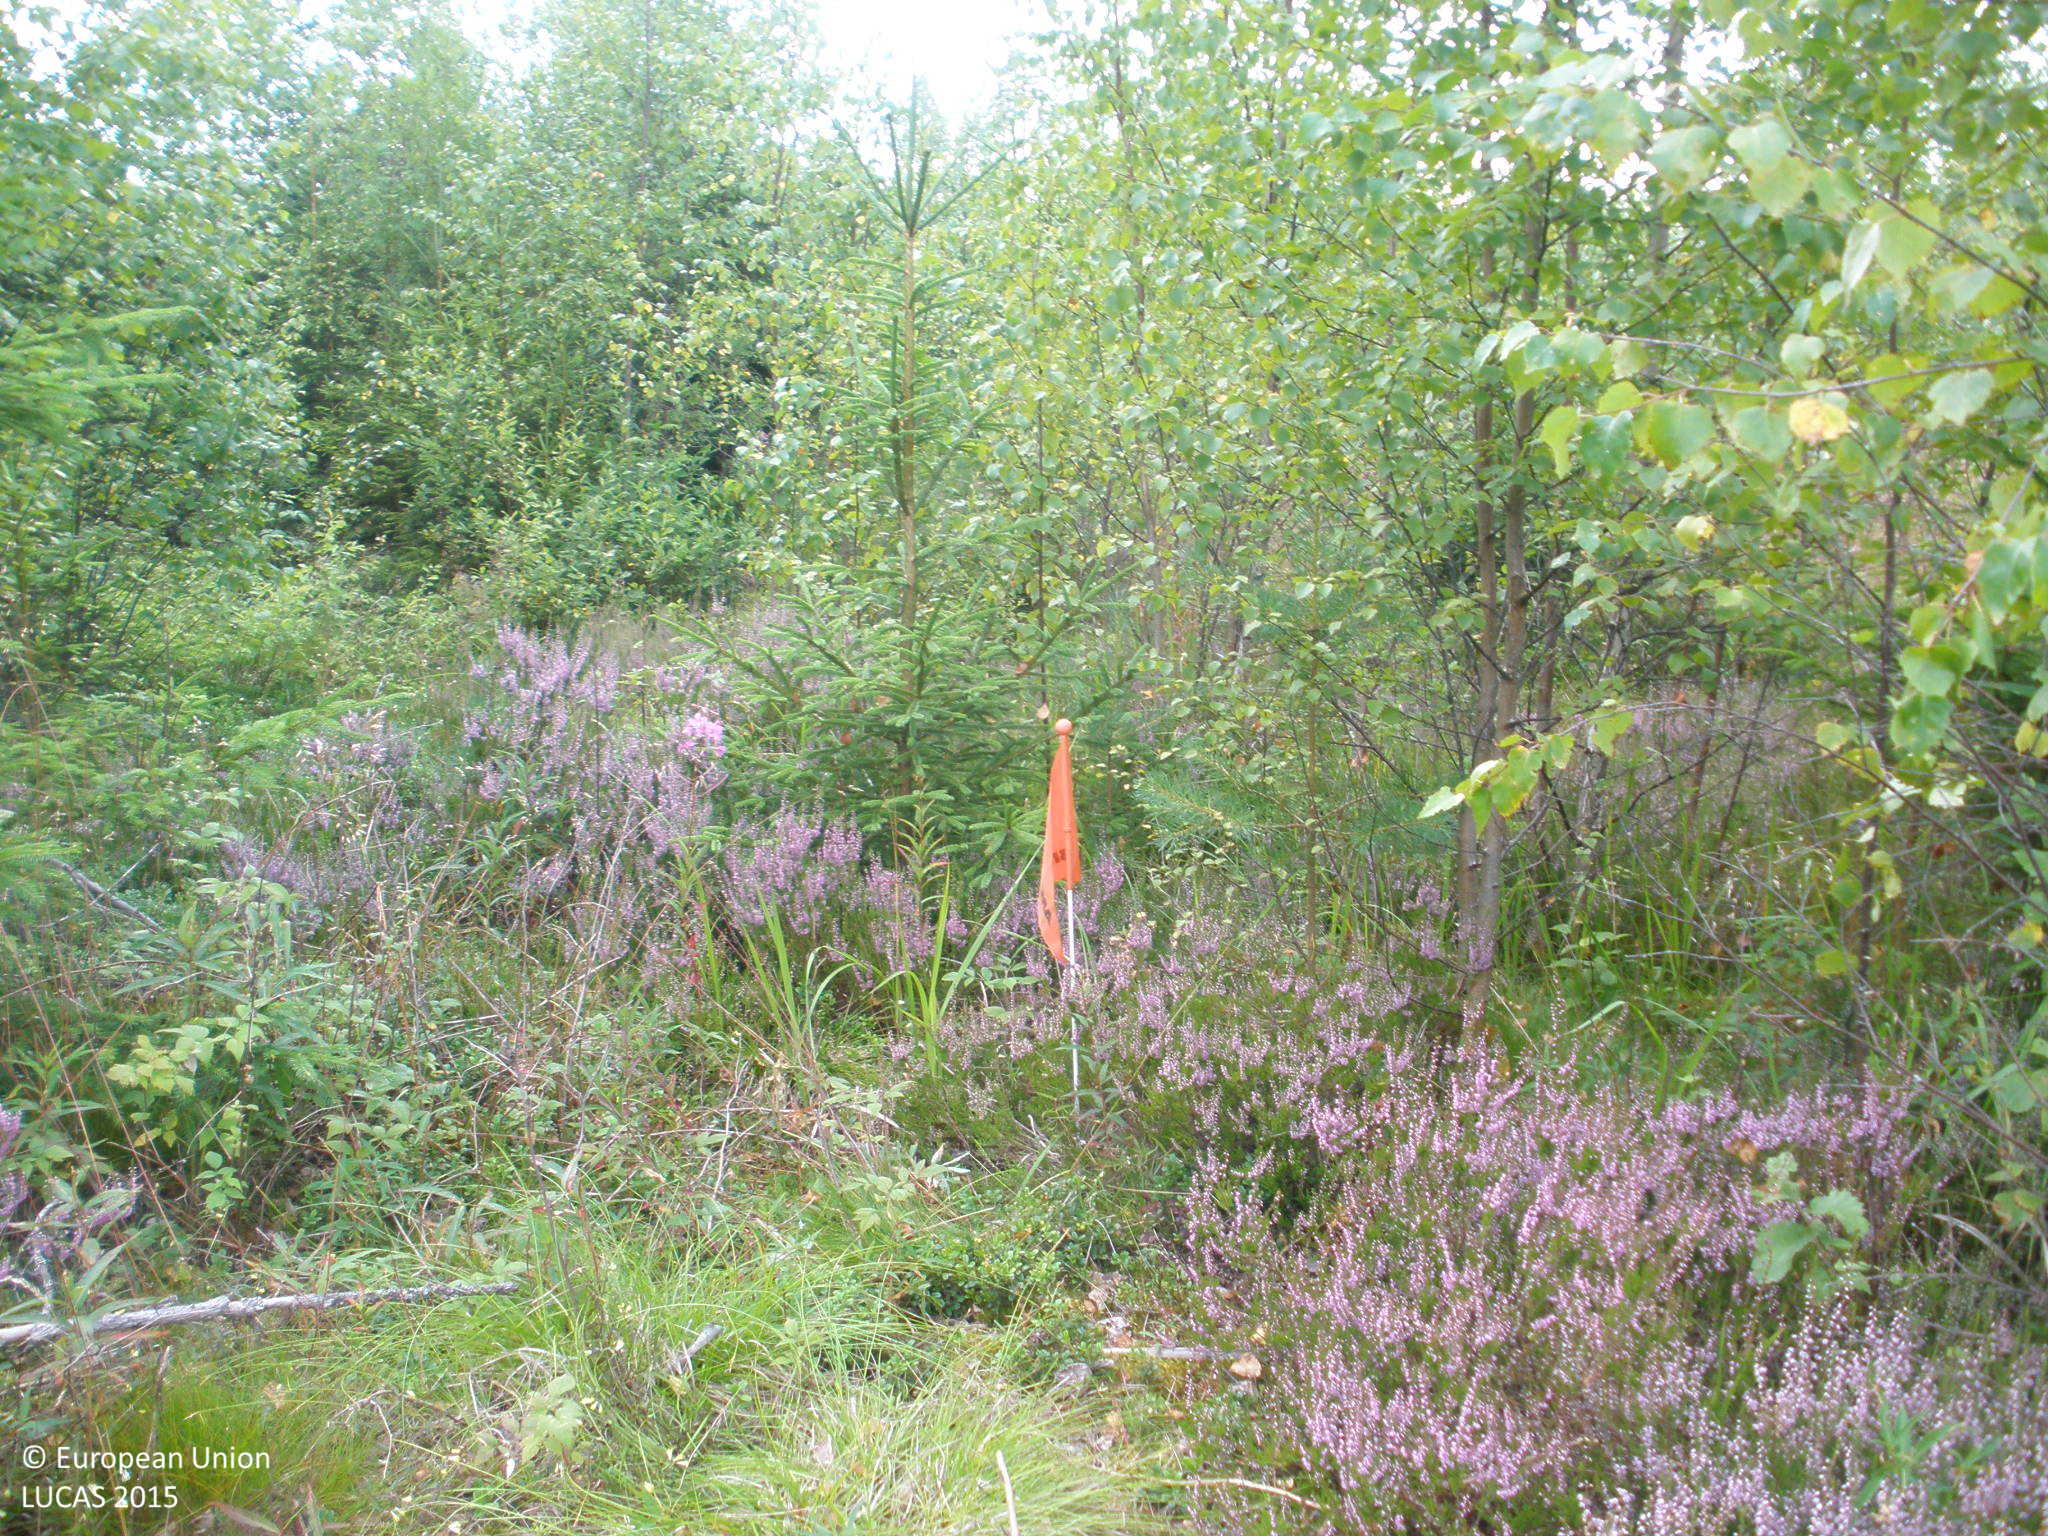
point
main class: Woodland
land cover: Spruce dominated mixed woodland
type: boreal forest
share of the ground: 50 - 75 %
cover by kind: broadleaved forest trees 35 %, coniferous forest trees 25 %, shrubs 20 %, herbaceous plants 20 %
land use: Forestry
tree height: < 5 m
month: August
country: FI
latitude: 60.7335
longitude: 24.2748
